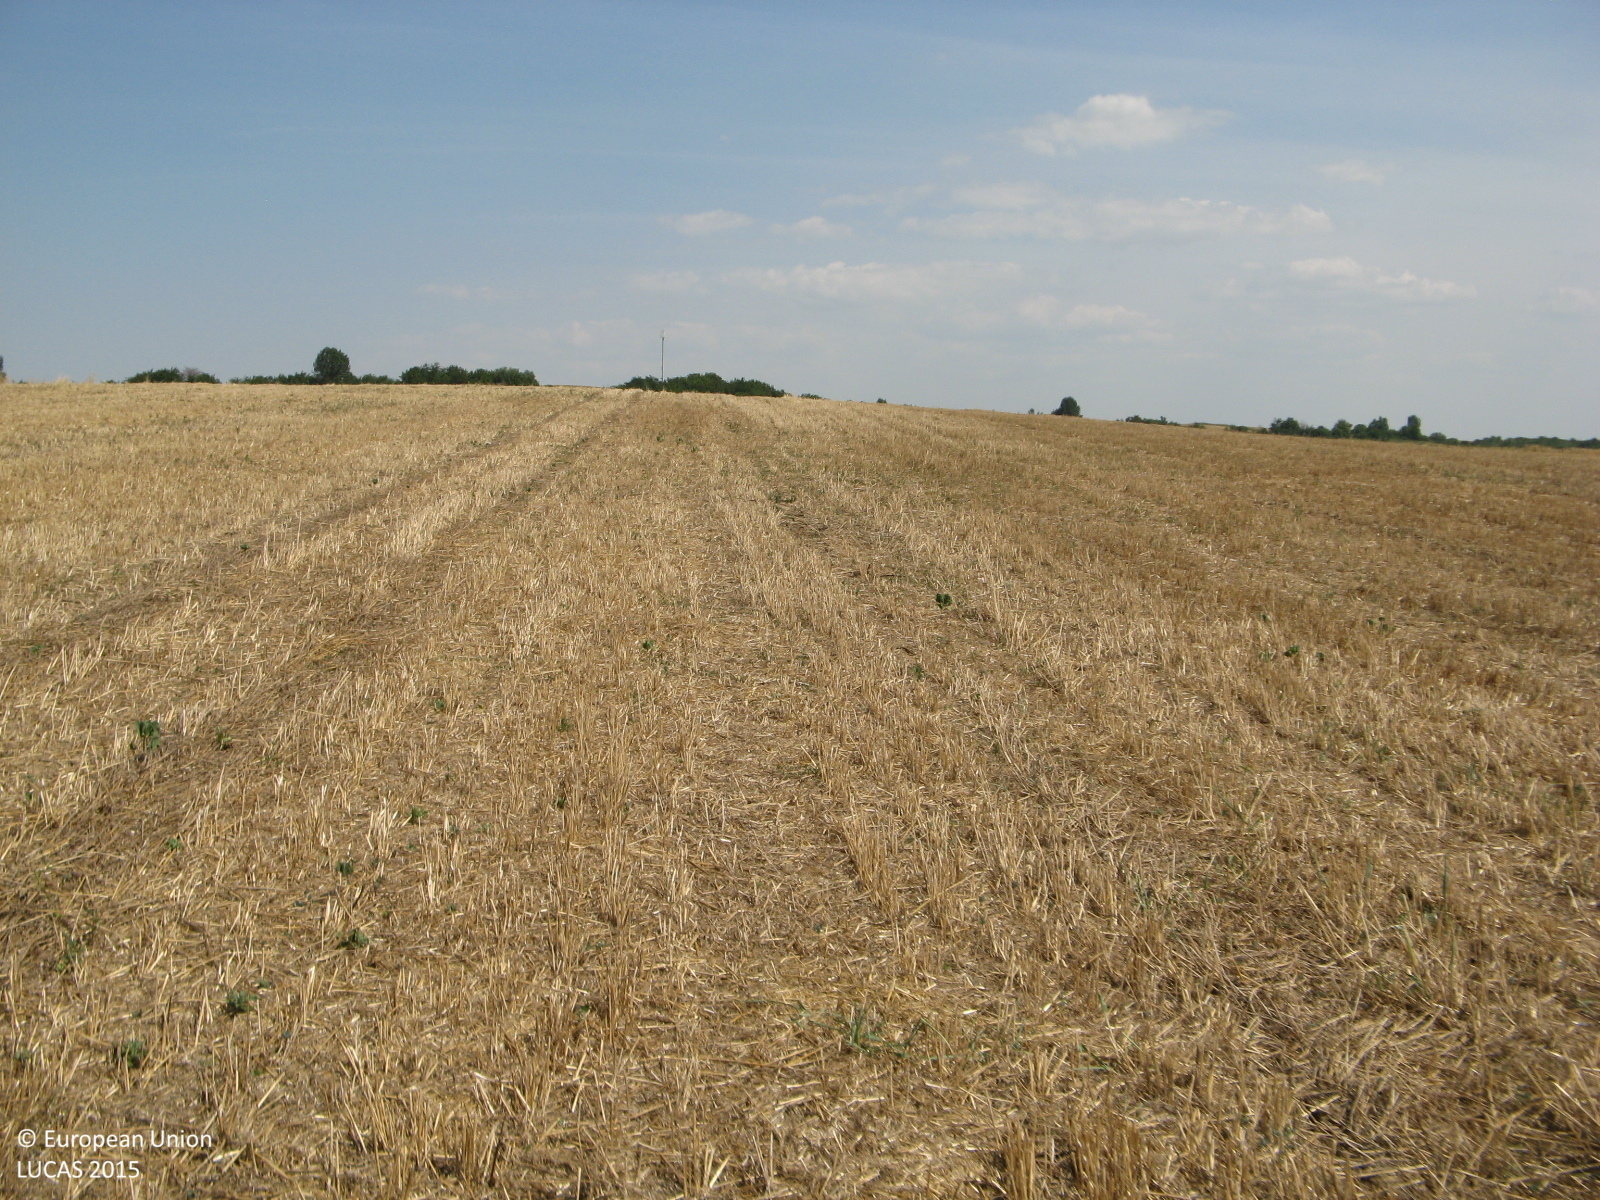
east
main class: Cropland
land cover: Common wheat
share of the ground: 50 - 75 %
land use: Agriculture (excluding fallow land and kitchen gardens)
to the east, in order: Common wheat
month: August
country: BG
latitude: 43.3666
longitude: 25.3418
